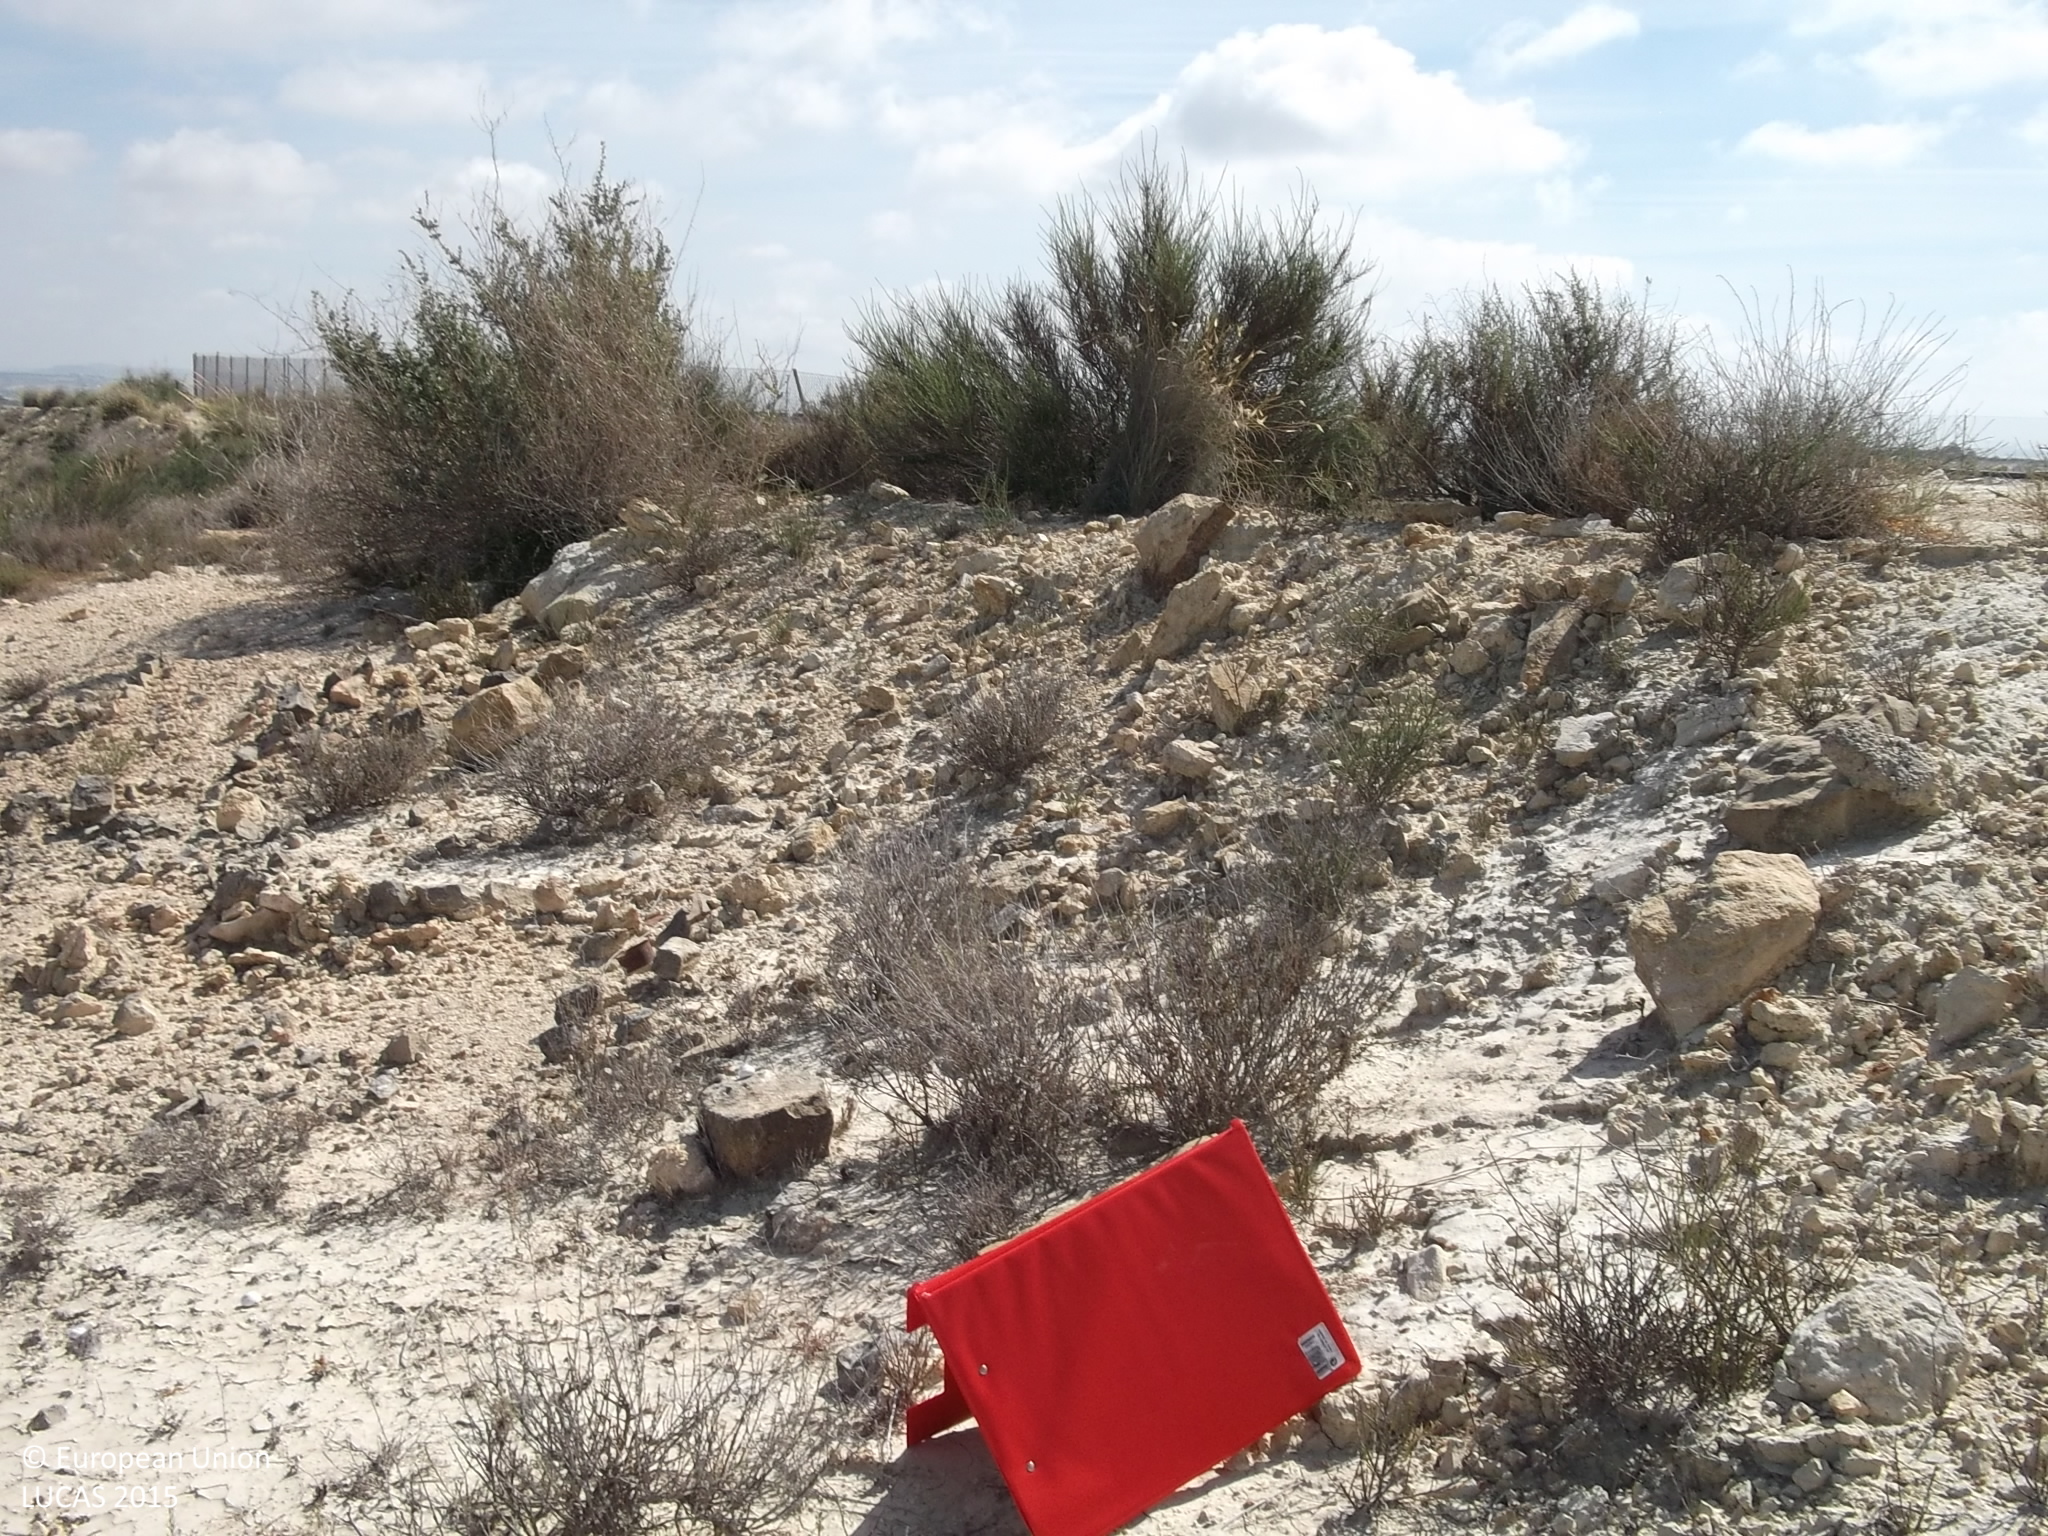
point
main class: Shrubland
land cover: Shrubland without tree cover
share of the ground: 25 - 50 %
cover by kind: shrubs 40 %, herbaceous plants 30 %, consolidated bare surface 30 %
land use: Semi-natural and natural areas not in use
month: May
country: ES
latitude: 37.9859
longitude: -0.8332
